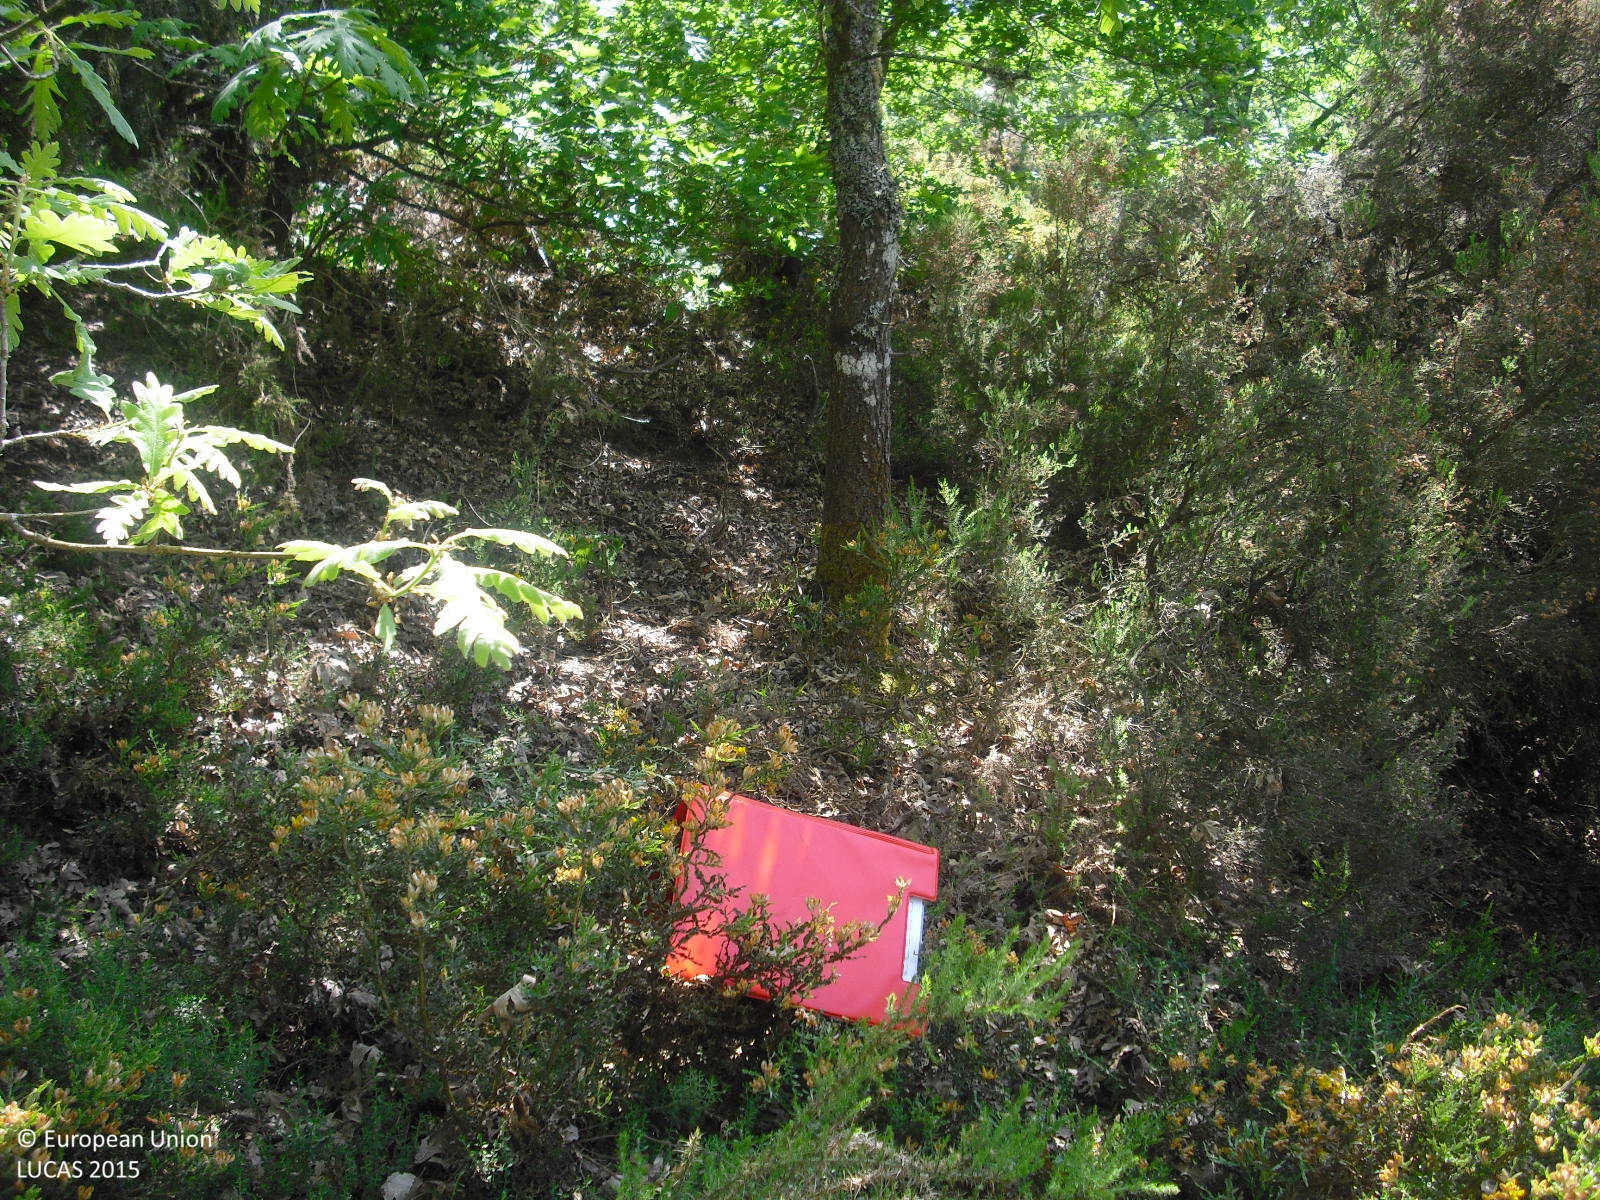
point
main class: Woodland
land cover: Broadleaved woodland
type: acidophilous oak and oak-birch forest
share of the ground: > 75 %
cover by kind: broadleaved forest trees 80 %, shrubs 20 %
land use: Semi-natural and natural areas not in use
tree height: > 5 m
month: May
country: ES
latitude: 42.1318
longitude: -7.5965
